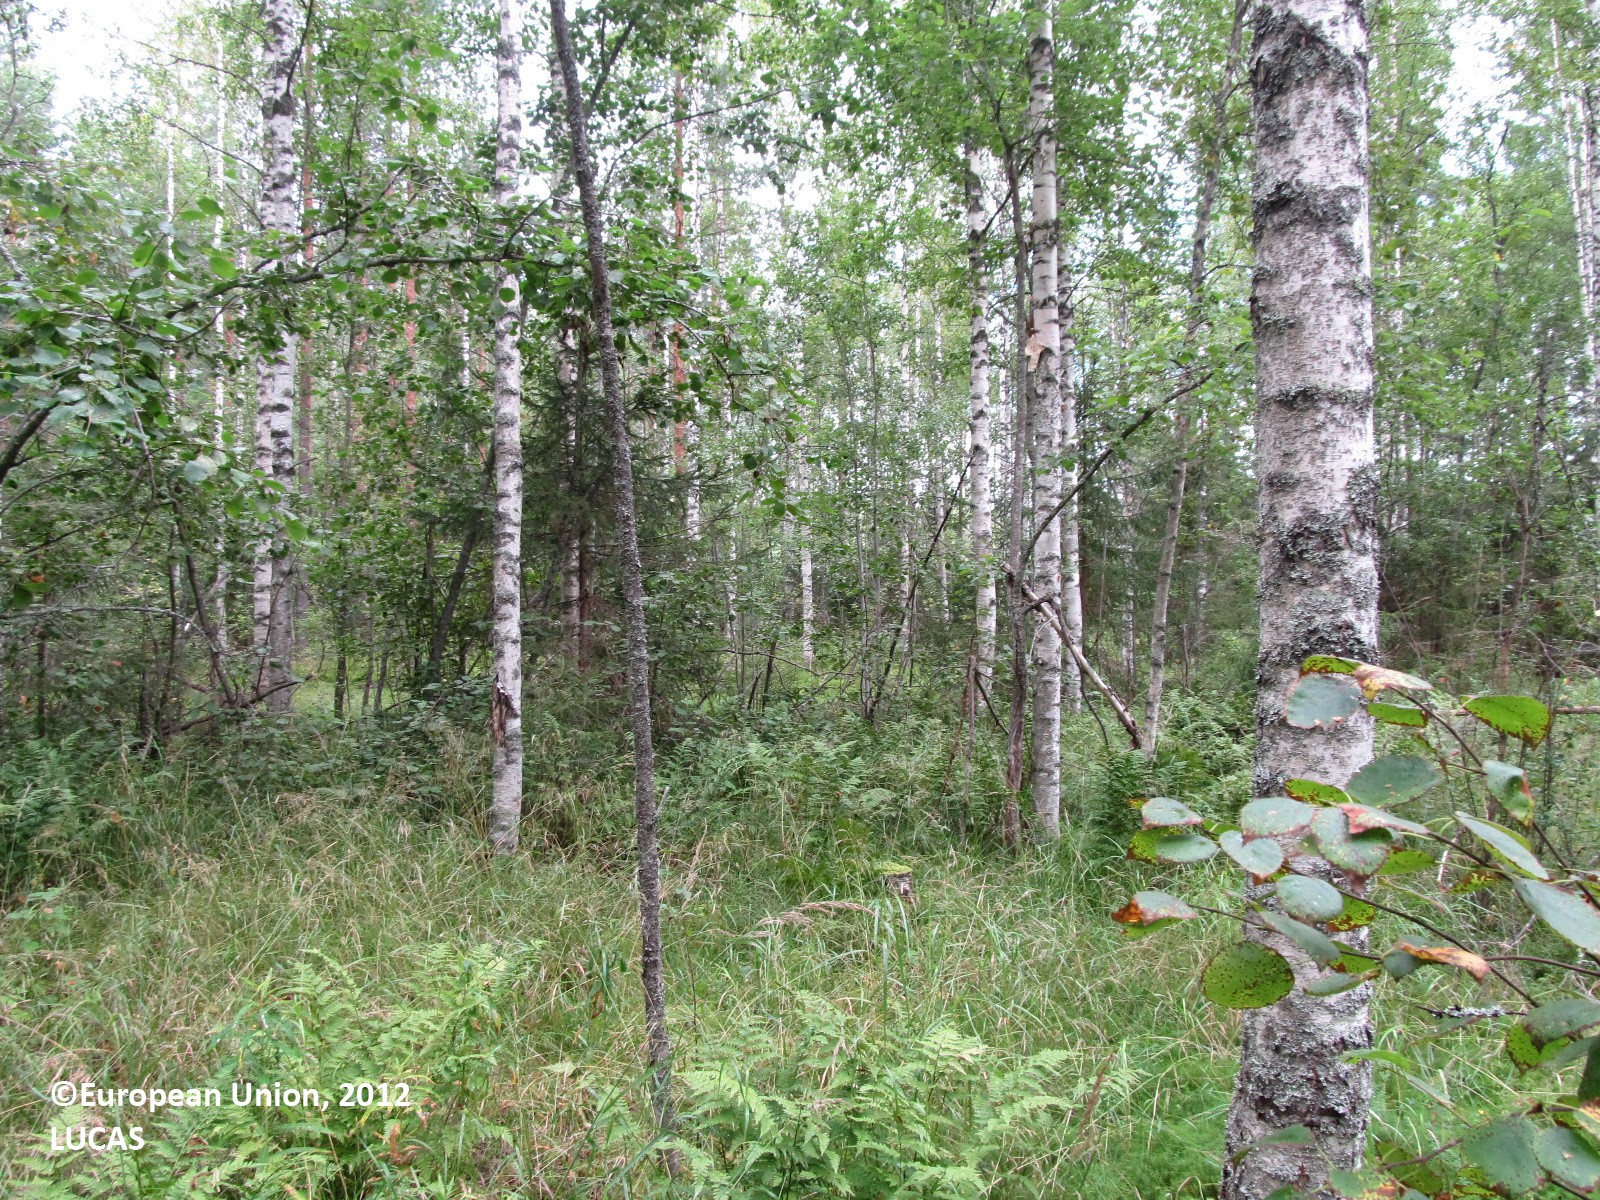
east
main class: Woodland
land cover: Spruce dominated mixed woodland
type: boreal forest
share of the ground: 25 - 50 %
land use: Forestry
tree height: > 5 m
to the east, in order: Spruce dominated mixed woodland; Broadleaved woodland; Ditches and canals; Broadleaved woodland; Ditches and canals; Spruce dominated coniferous woodland; Broadleaved woodland
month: August
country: FI
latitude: 62.0109
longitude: 27.4177
